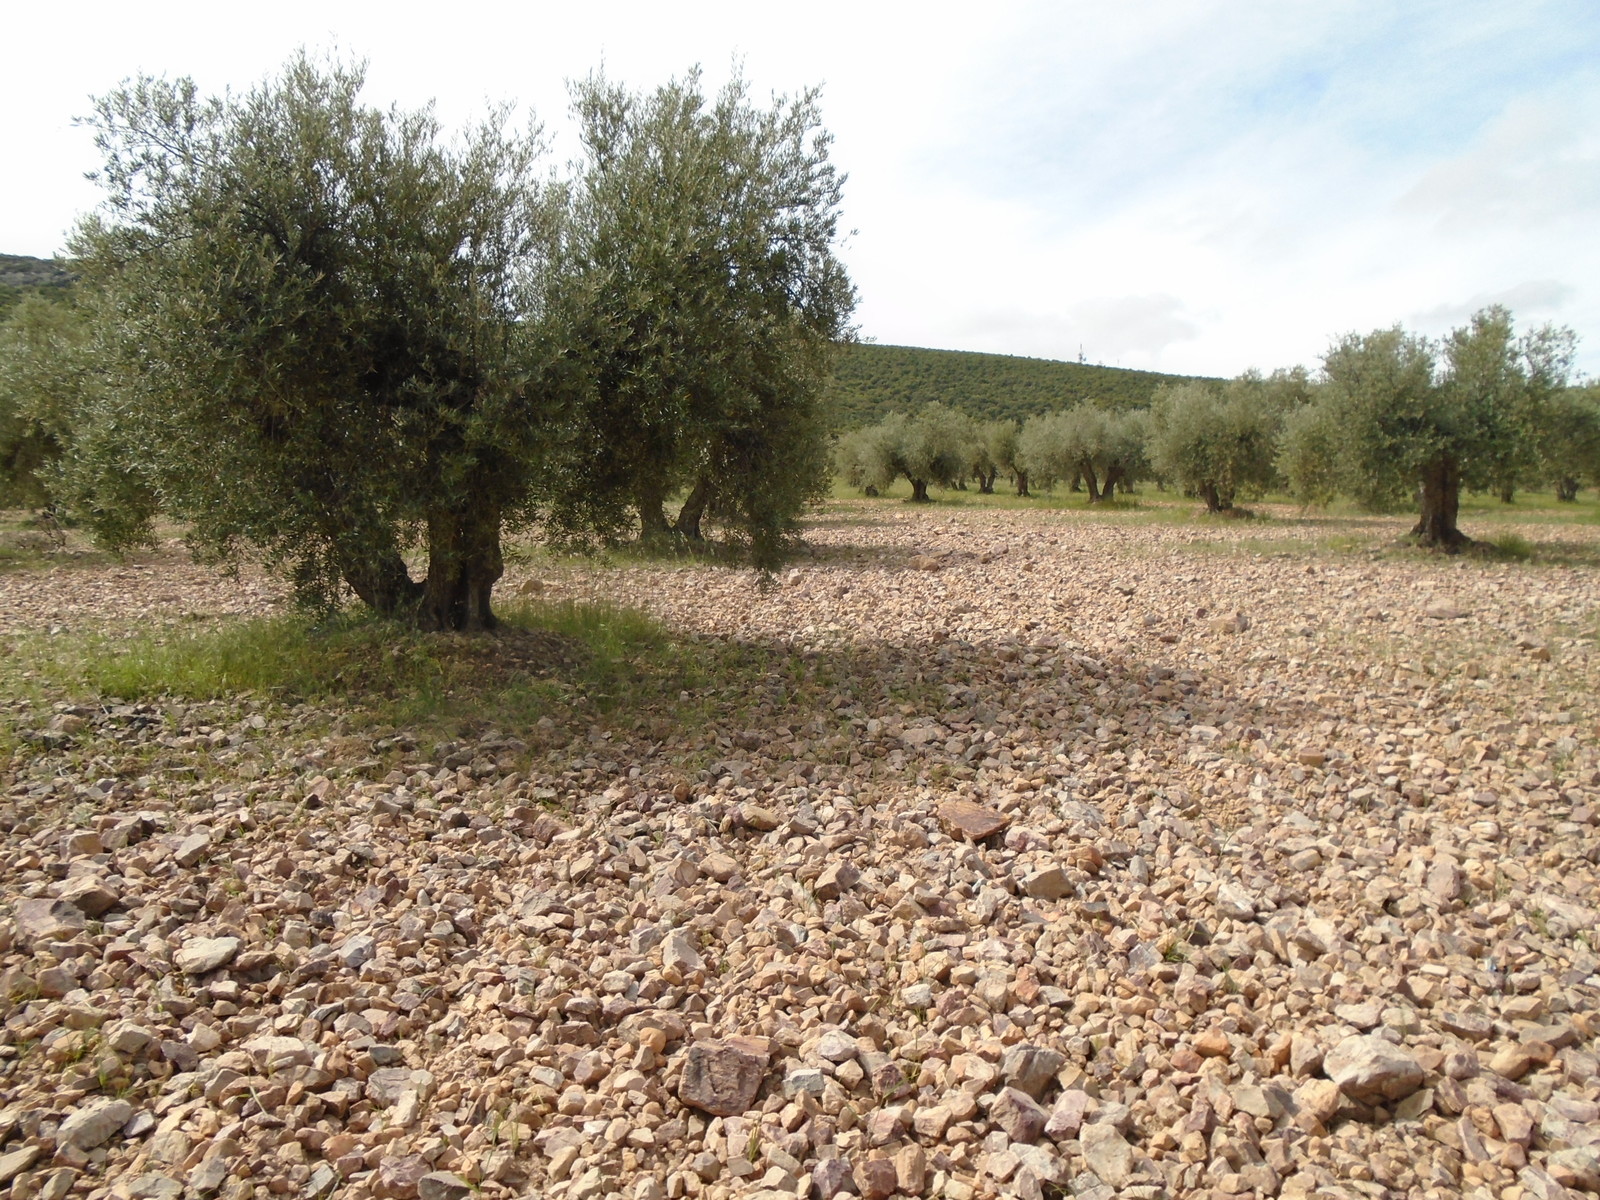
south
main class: Cropland
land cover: Olive groves
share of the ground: 10 - 25 %
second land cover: Spontaneously vegetated surfaces
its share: > 75 %
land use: Agriculture (excluding fallow land and kitchen gardens)
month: May
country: ES
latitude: 39.6643
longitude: -3.7240
